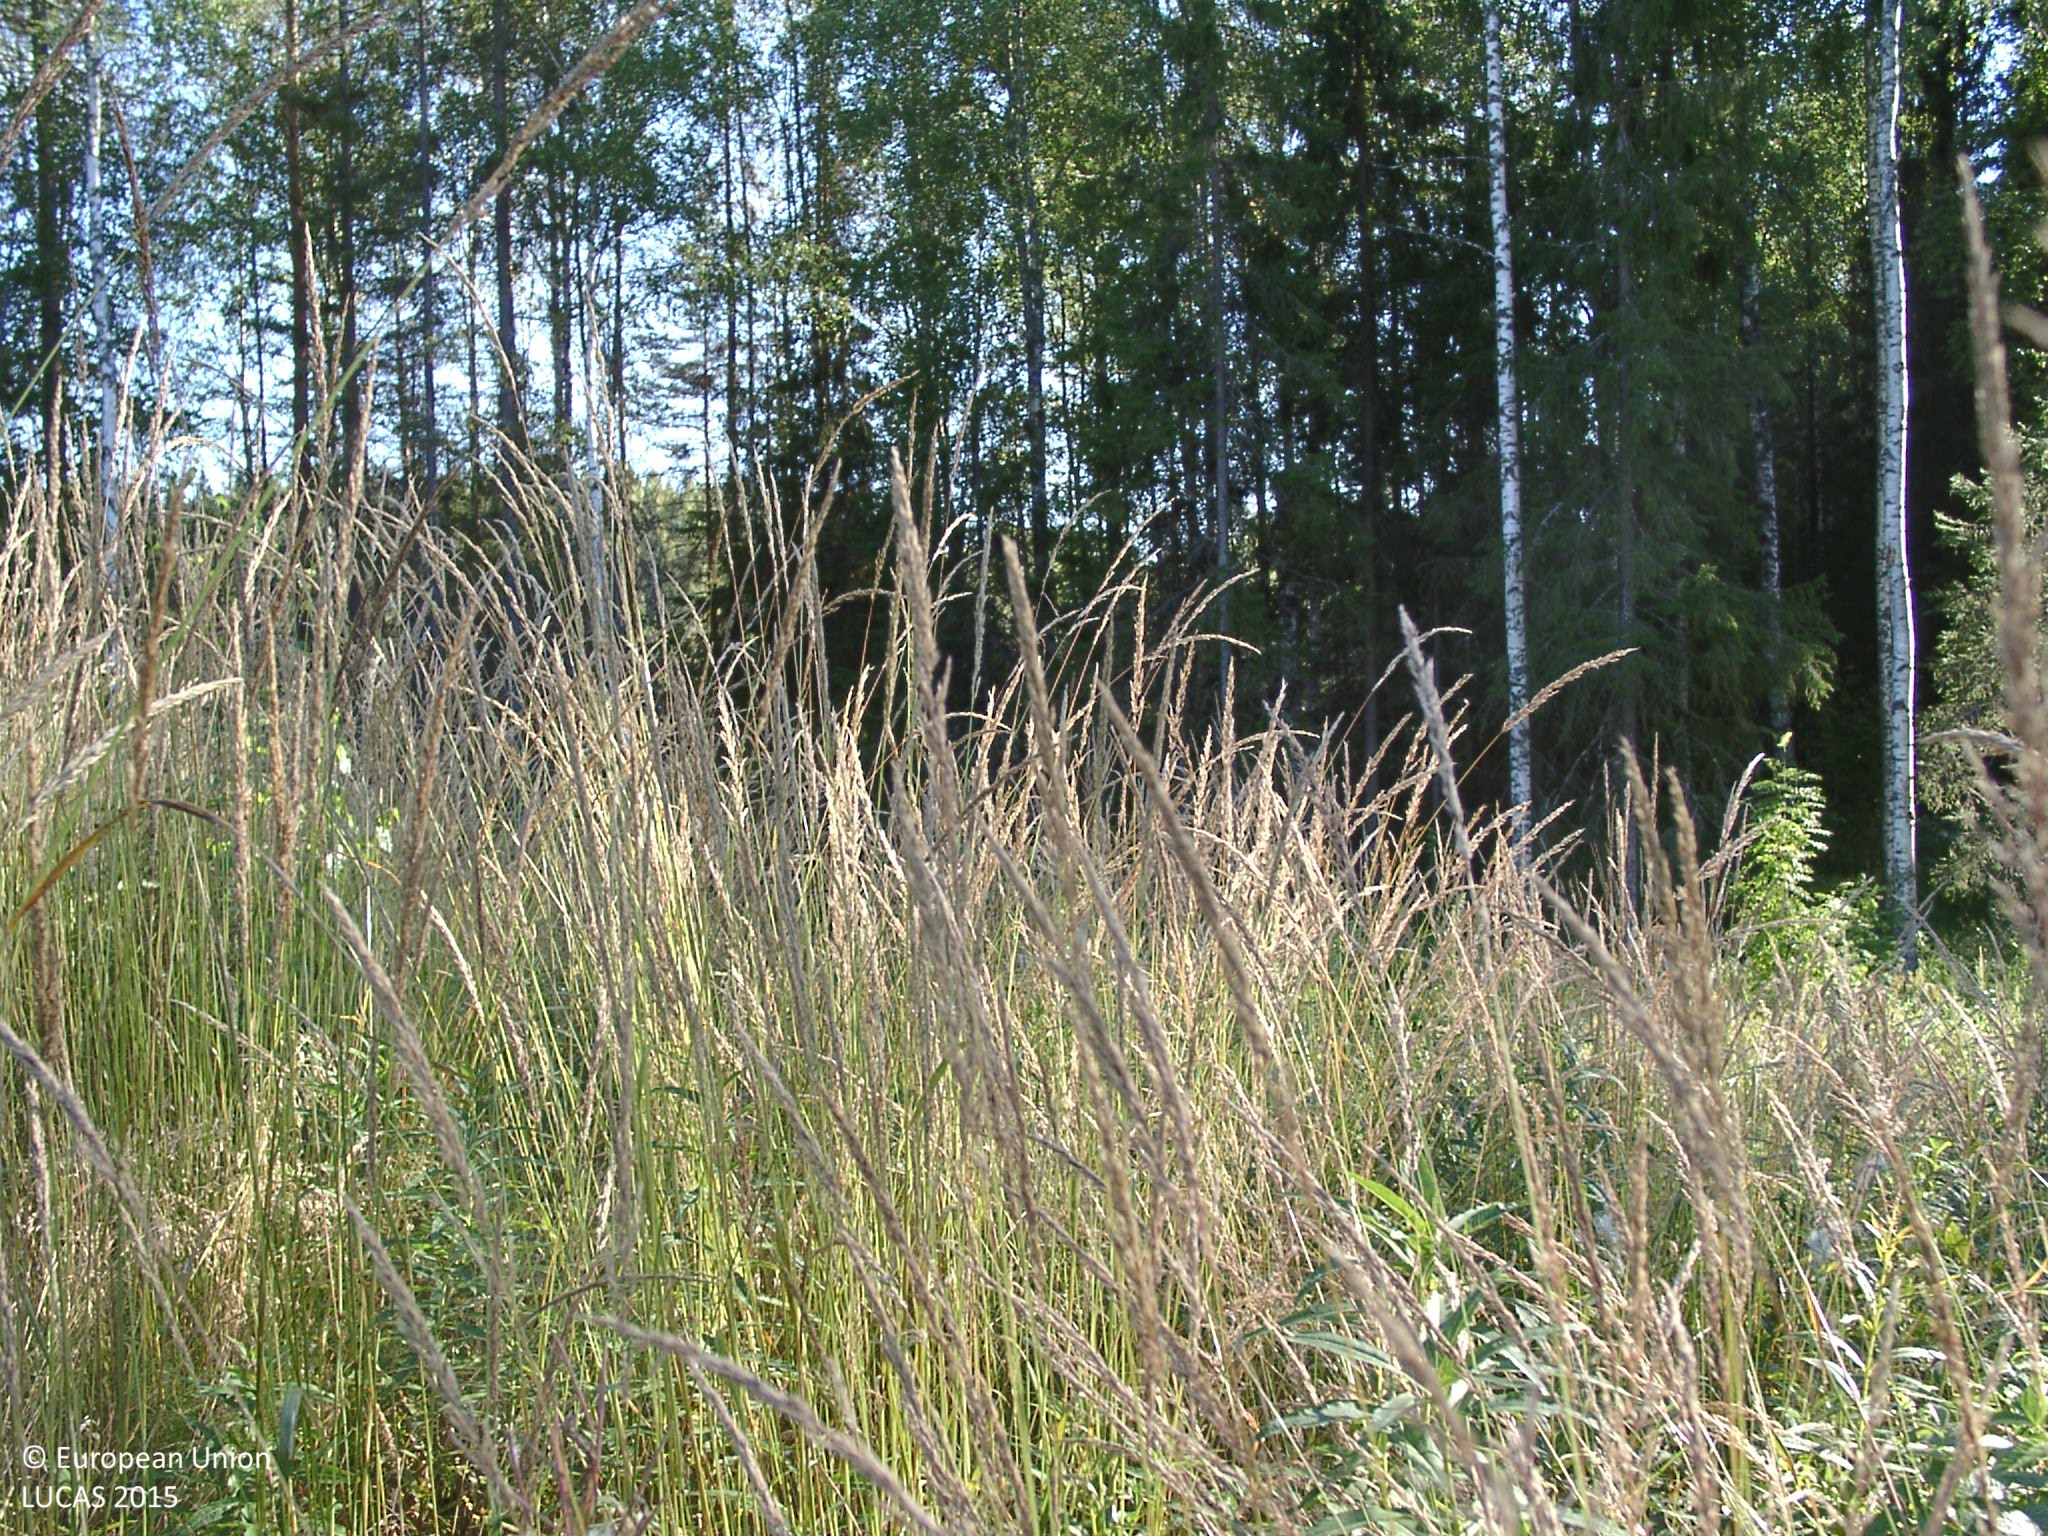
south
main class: Grassland
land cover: Grassland with sparse tree/shrub cover
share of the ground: > 75 %
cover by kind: herbaceous plants 90 %, coniferous forest trees 5 %, shrubs 5 %
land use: Forestry
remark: Clear cut
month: August
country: FI
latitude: 61.9087
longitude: 25.0119
